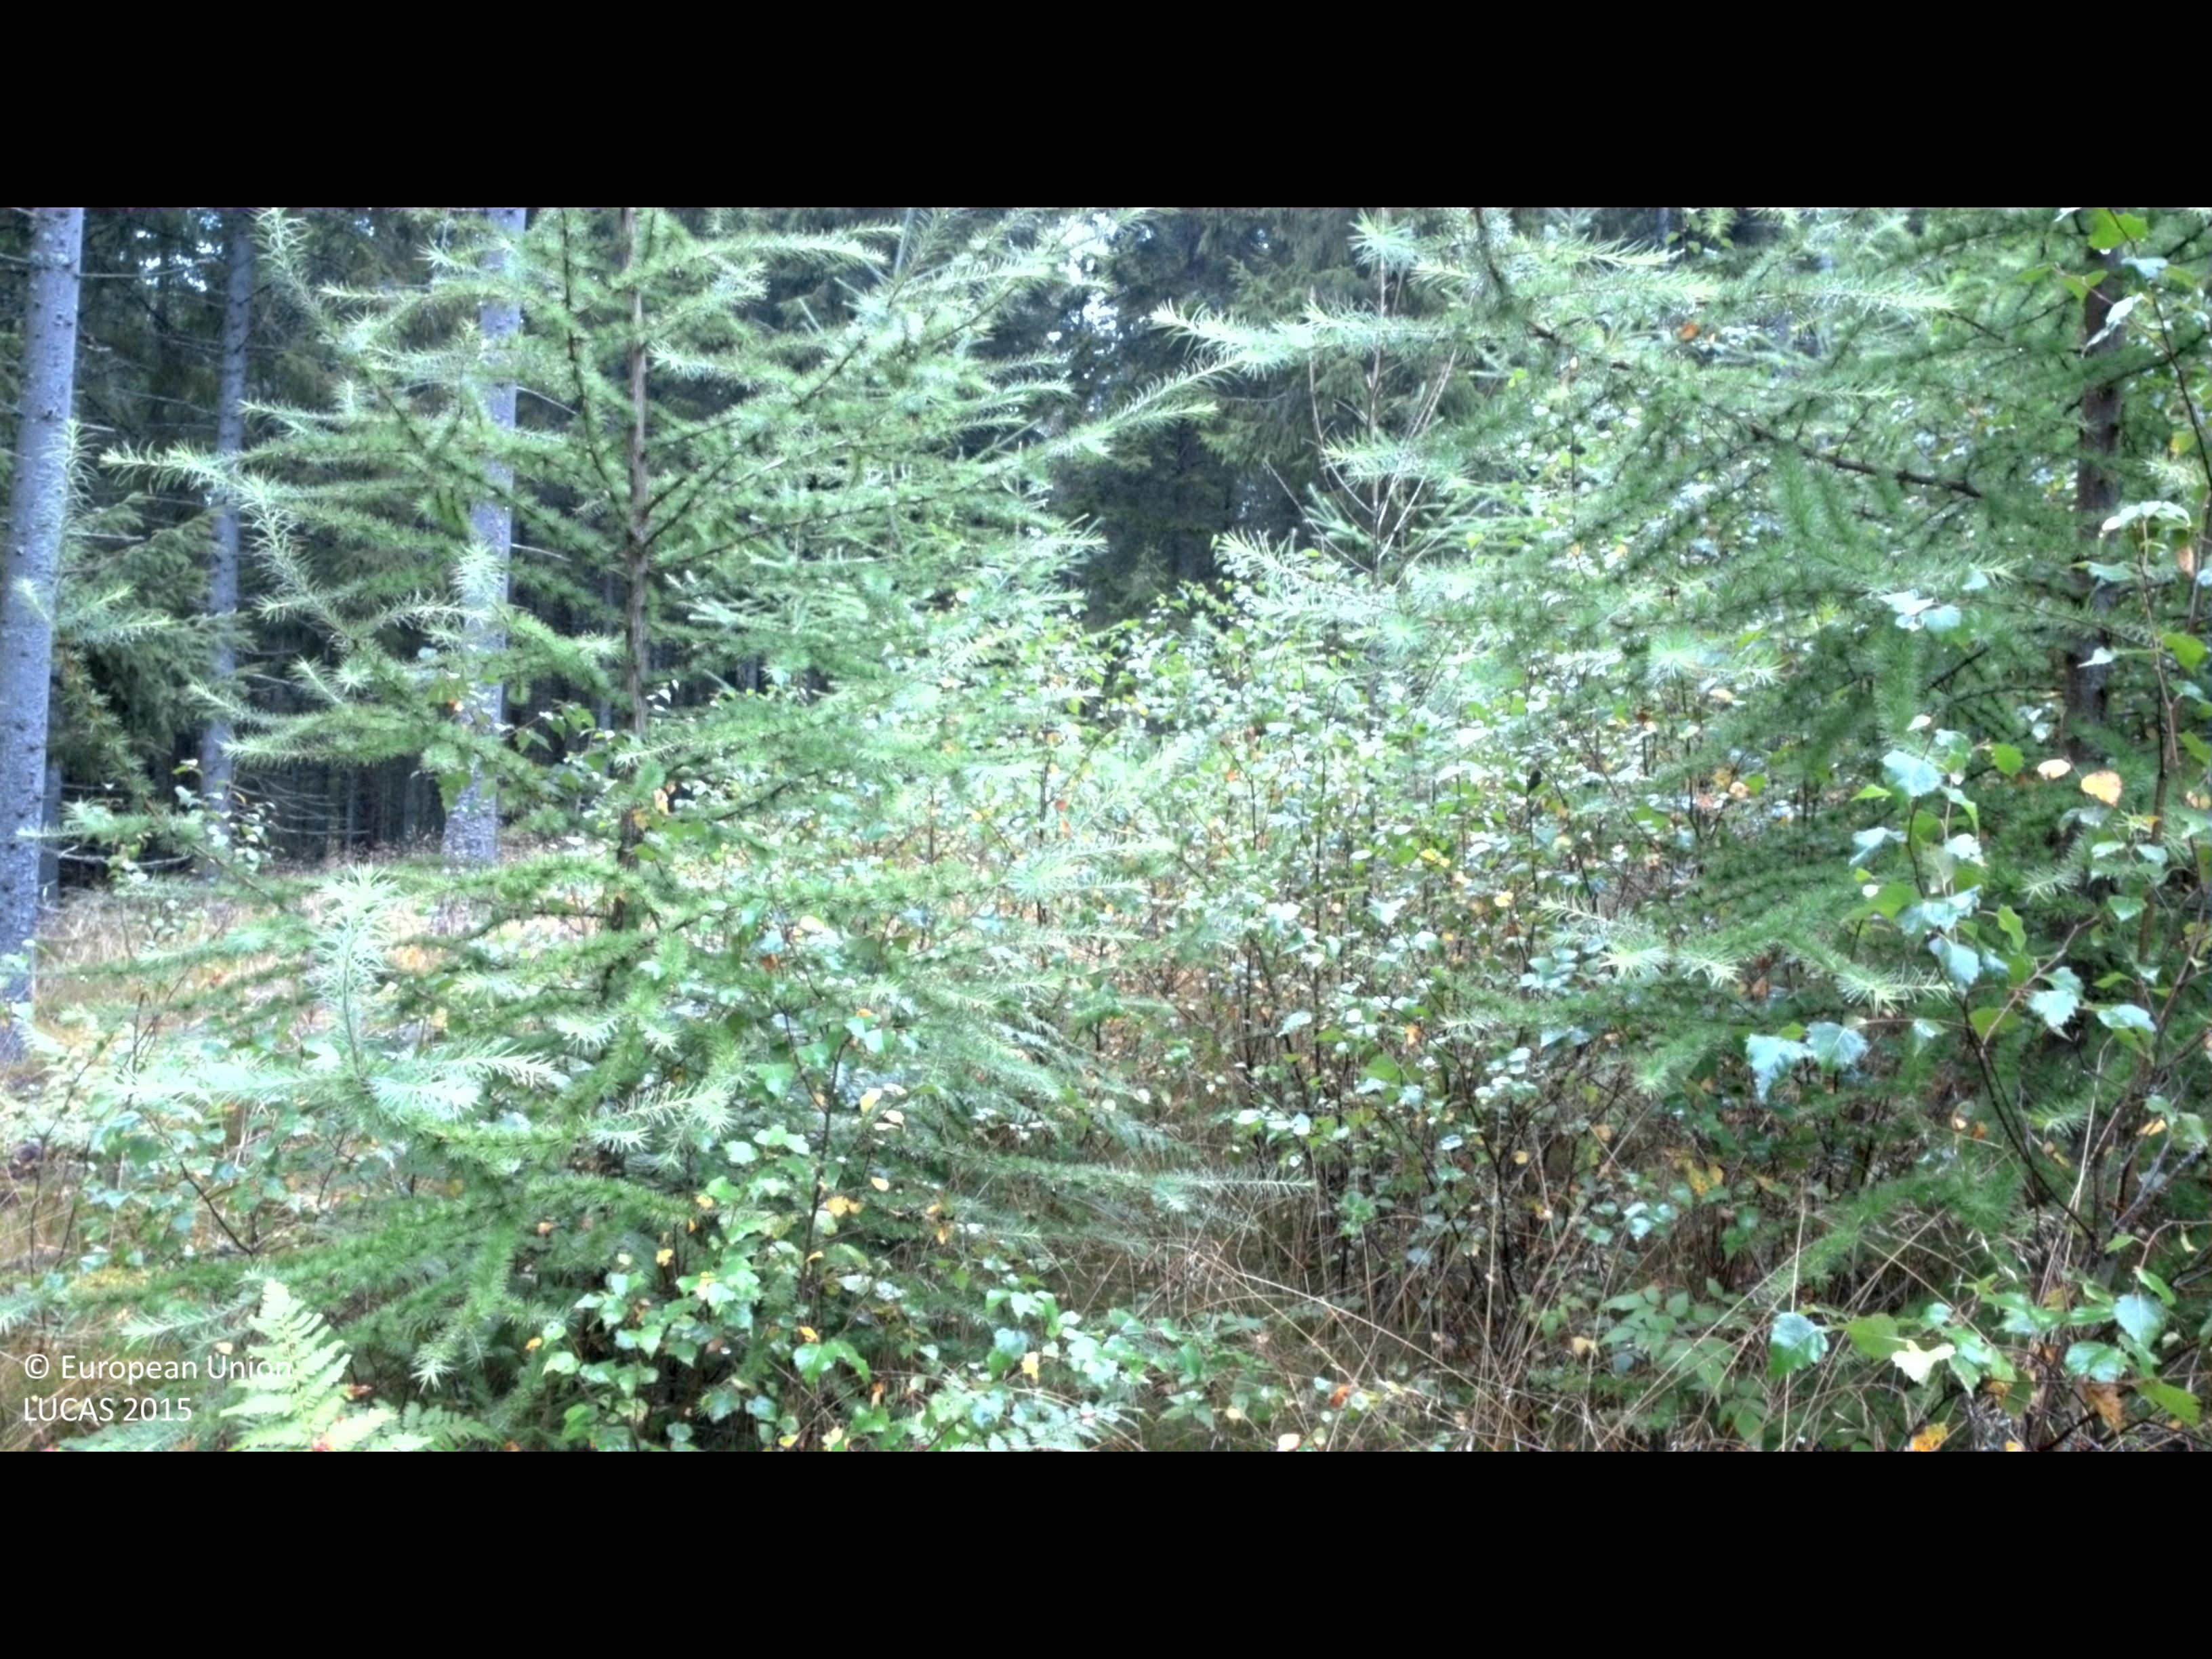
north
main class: Woodland
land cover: Other mixed woodland
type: boreal forest
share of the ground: 50 - 75 %
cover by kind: coniferous forest trees 35 %, broadleaved forest trees 35 %, shrubs 15 %, herbaceous plants 15 %
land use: Forestry
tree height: < 5 m
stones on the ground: 10 - 25 %
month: August
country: SE
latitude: 57.3366
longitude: 13.8334
